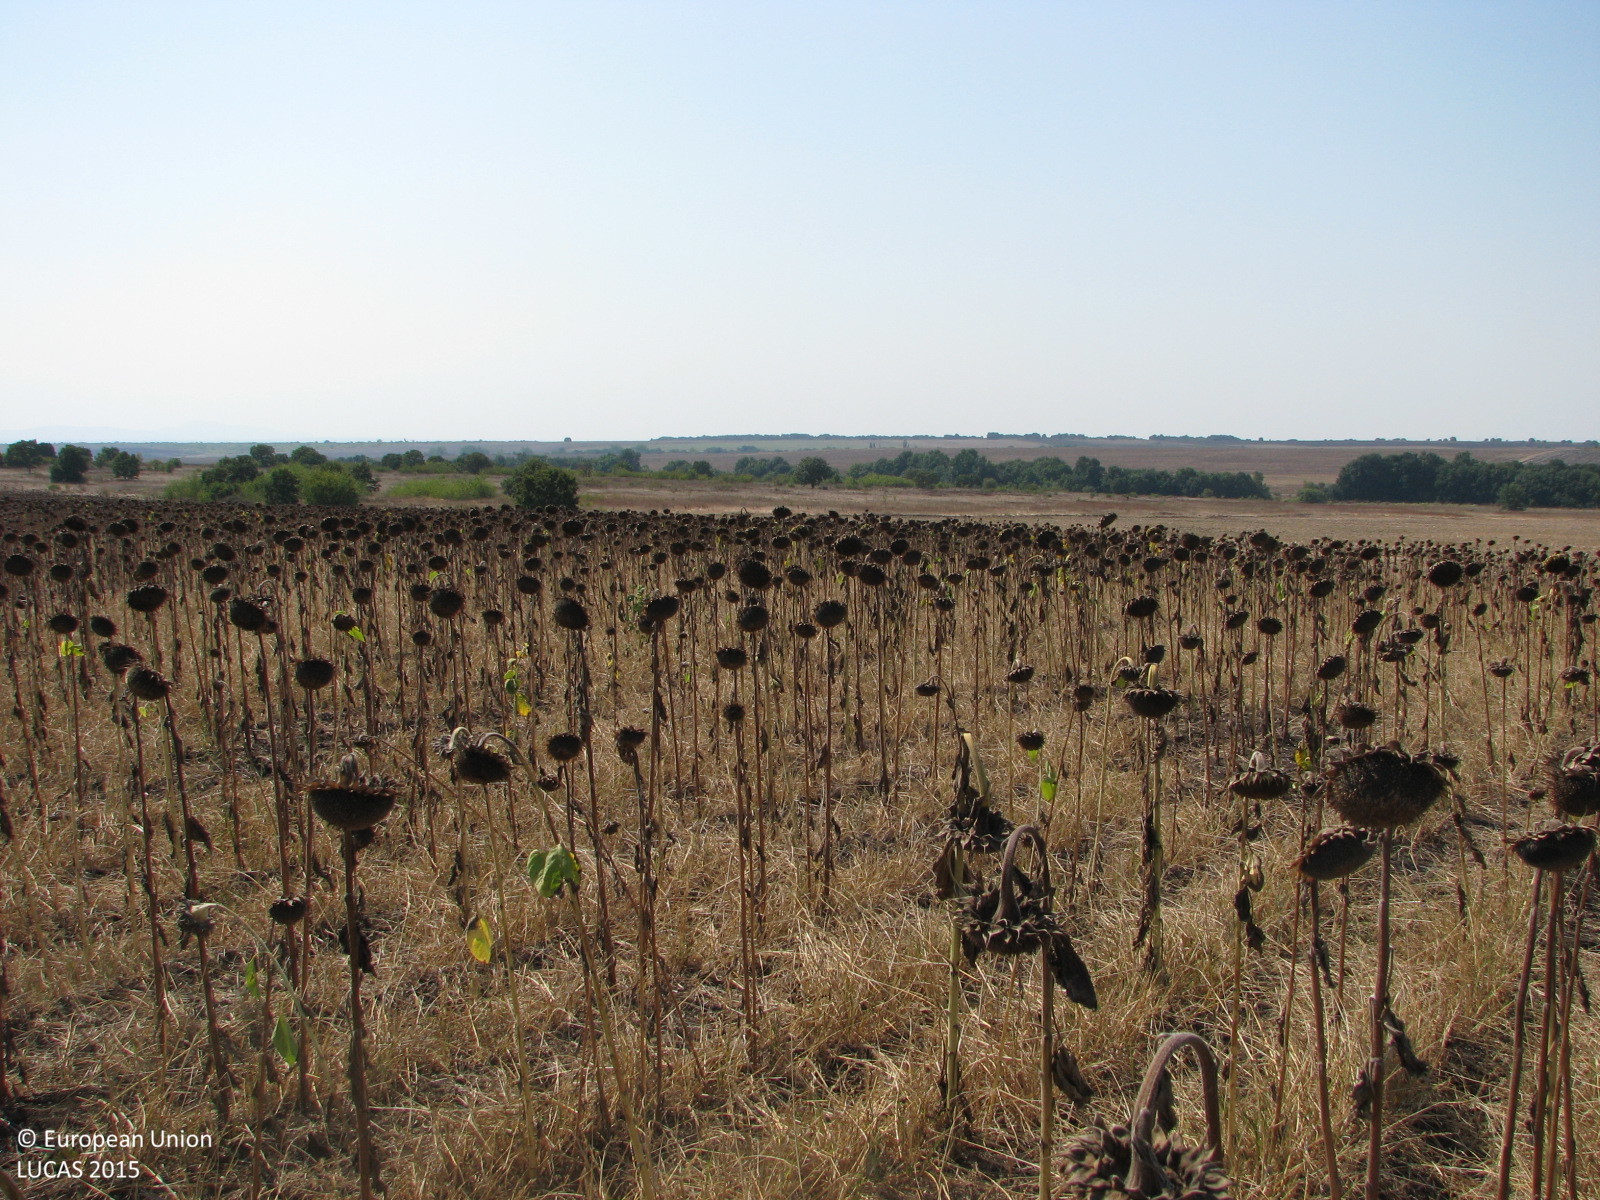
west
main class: Cropland
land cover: Sunflower
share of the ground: 50 - 75 %
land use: Agriculture (excluding fallow land and kitchen gardens)
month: September
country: BG
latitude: 42.3669
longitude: 26.7691
